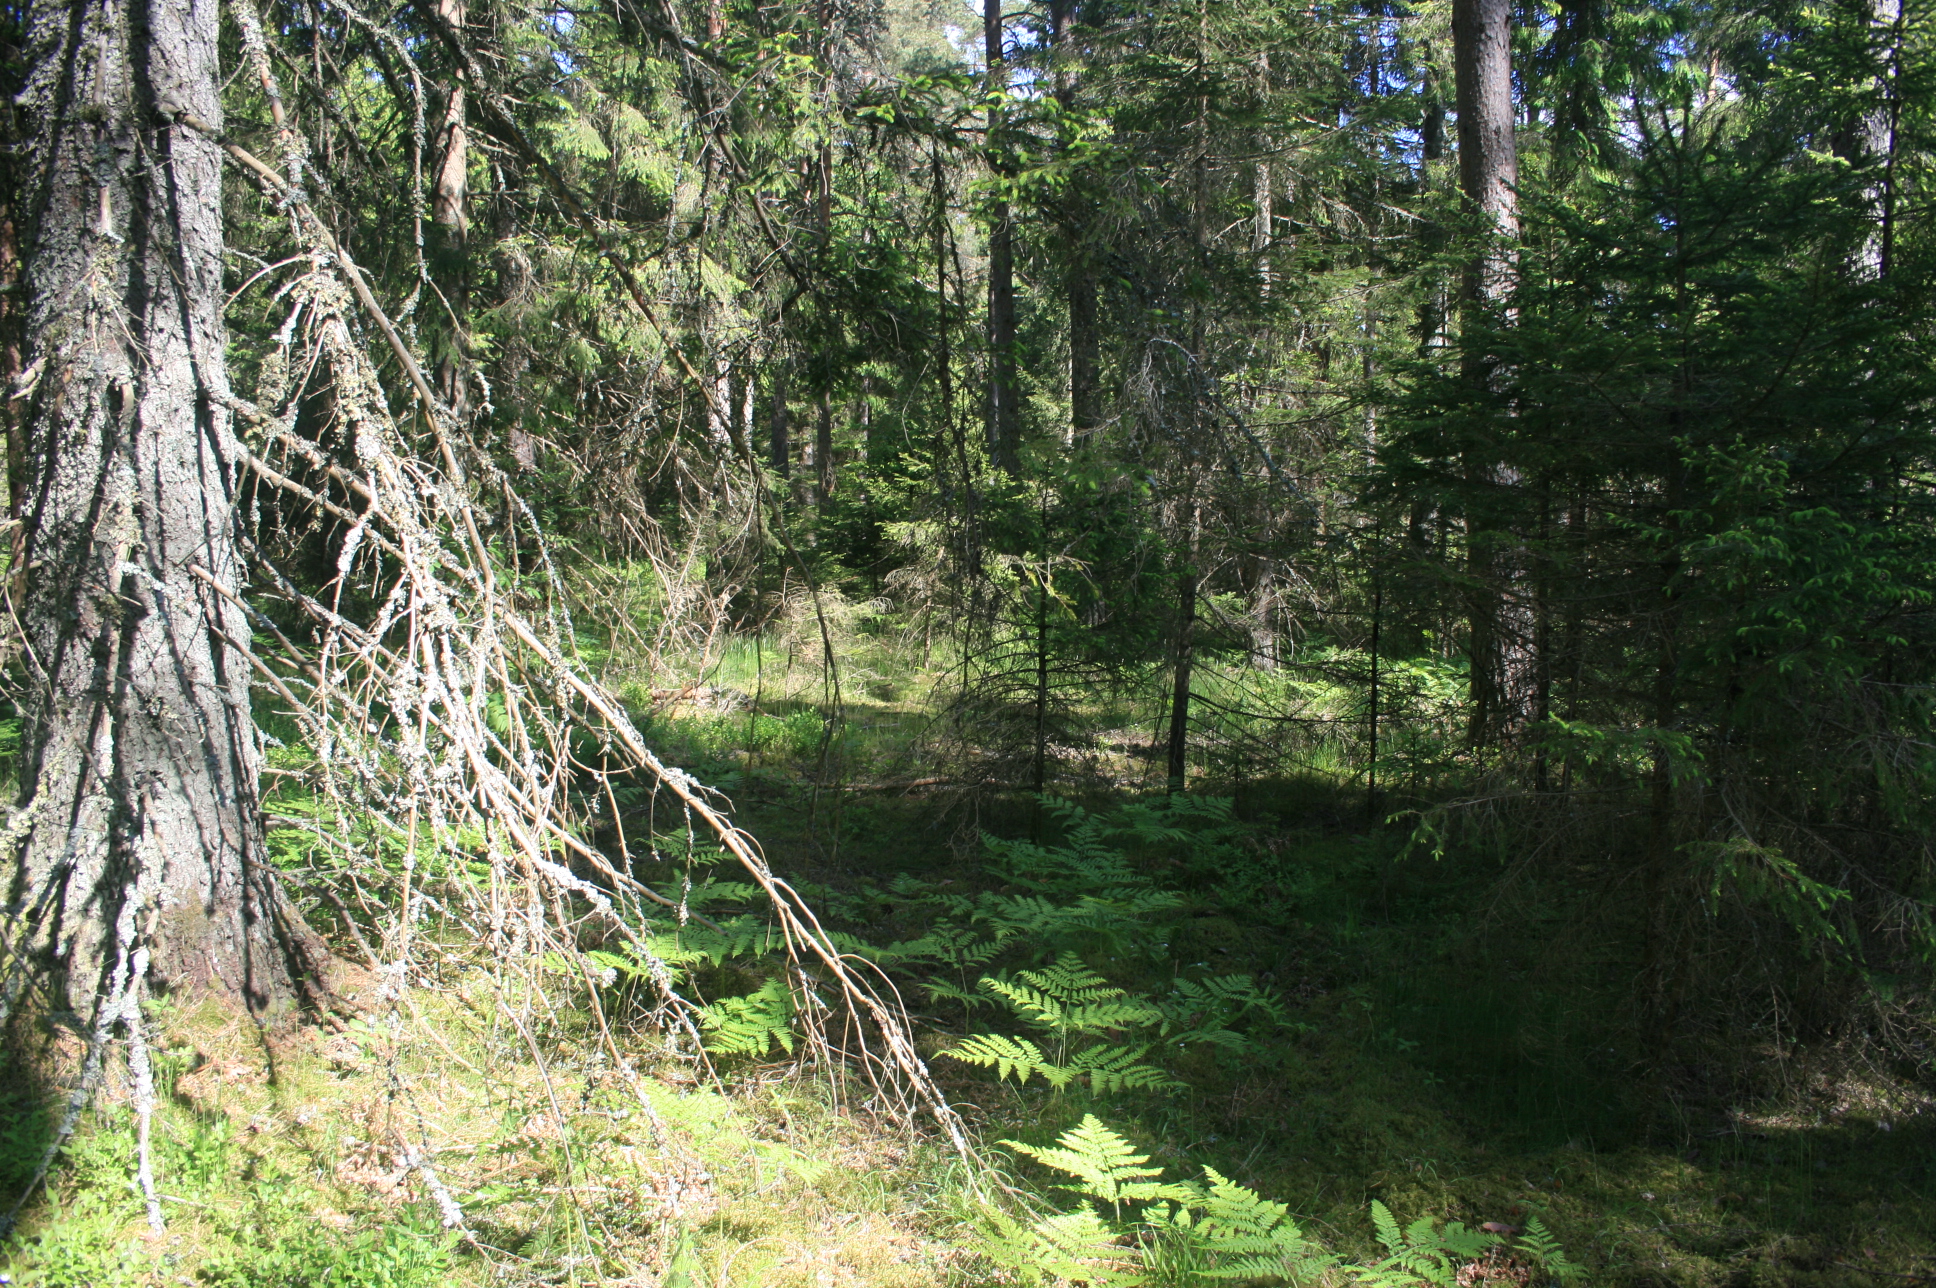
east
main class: Woodland
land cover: Spruce dominated coniferous woodland
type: hemiboreal forest and nemoral coniferous forest and mixed broadleaved-coniferous forest
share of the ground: > 75 %
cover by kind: coniferous forest trees 85 %, broadleaved forest trees 10 %, herbaceous plants 5 %
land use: Forestry
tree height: > 5 m
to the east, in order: Spruce dominated coniferous woodland; Groves; Grass margins; Paved roads, cycling and walking lanes; Grassland without tree/shrub cover; Spruce dominated mixed woodland
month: June
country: LT
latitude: 55.7976
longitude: 22.2588
